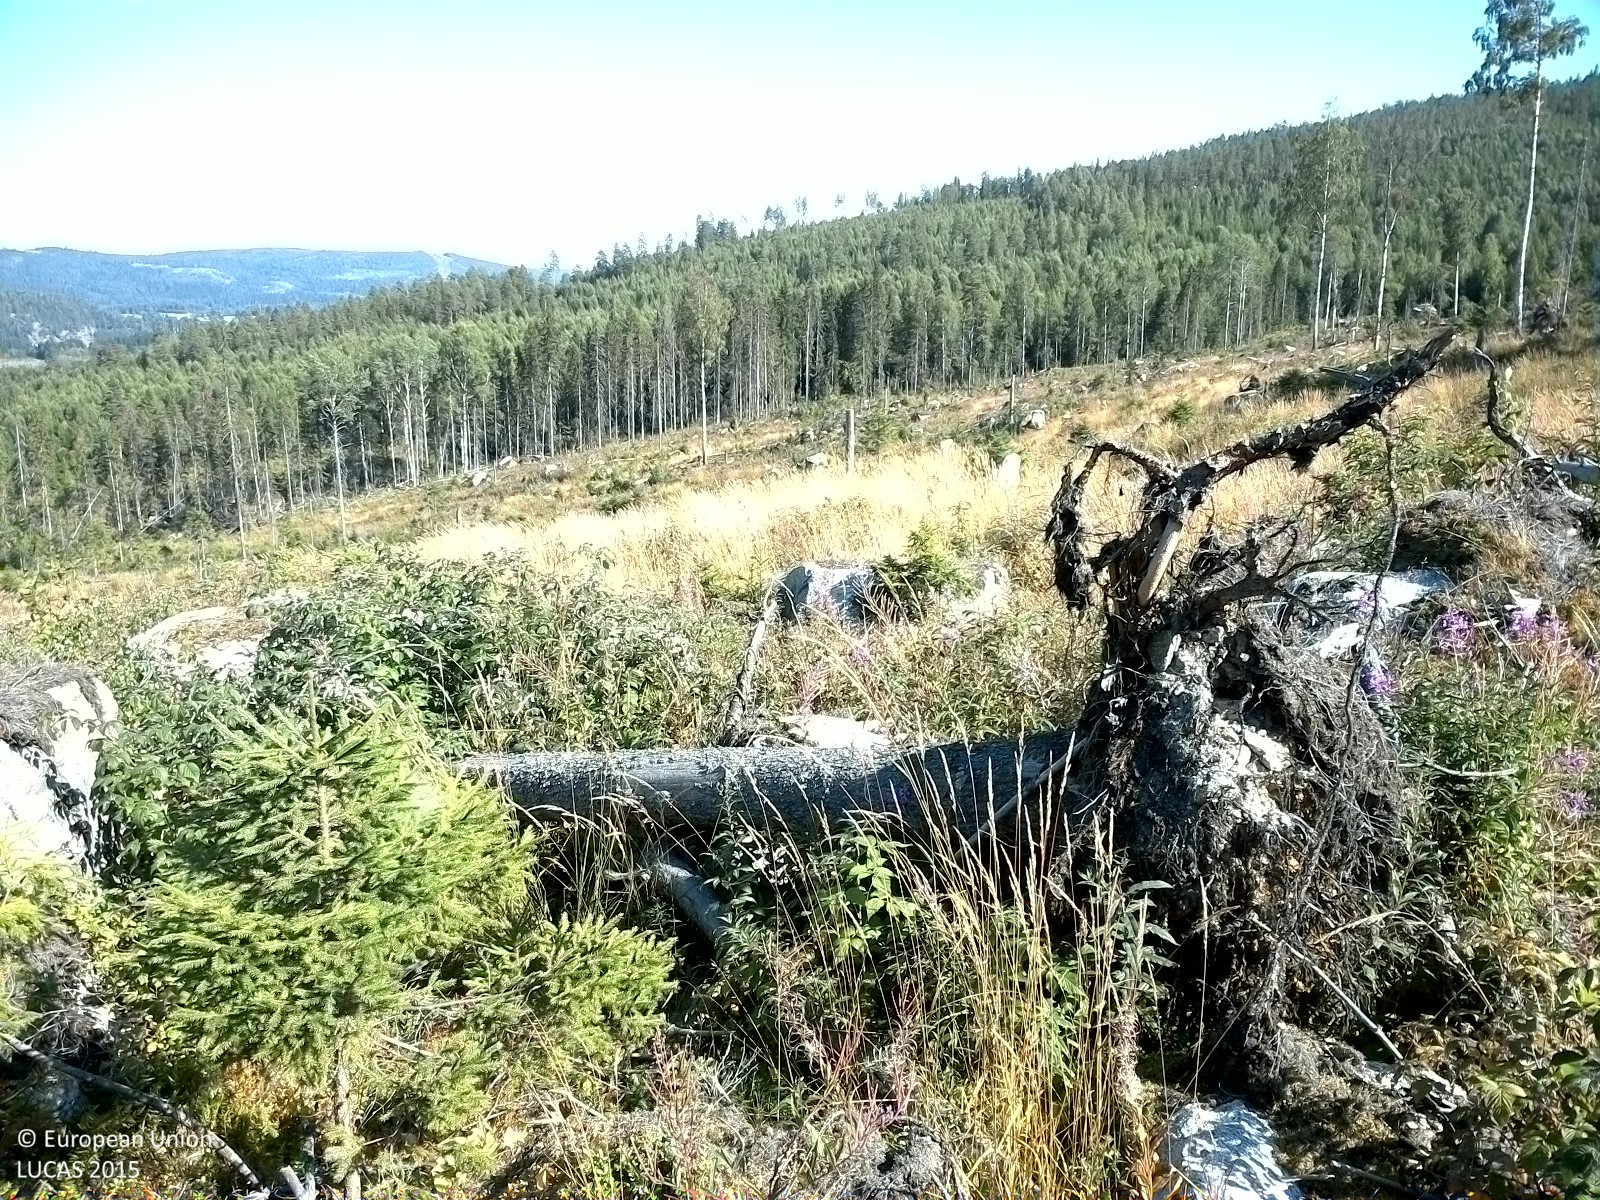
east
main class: Woodland
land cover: Spruce dominated mixed woodland
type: boreal forest
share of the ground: 10 - 25 %
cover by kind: herbaceous plants 55 %, shrubs 35 %, coniferous forest trees 5 %, broadleaved forest trees 5 %
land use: Forestry
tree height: < 5 m
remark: Clear cut
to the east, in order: Spruce dominated mixed woodland; Shrubland with sparse tree cover; Spruce dominated mixed woodland; Grassland with sparse tree/shrub cover; Spruce dominated mixed woodland
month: August
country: SE
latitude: 62.3663
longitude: 16.8408
